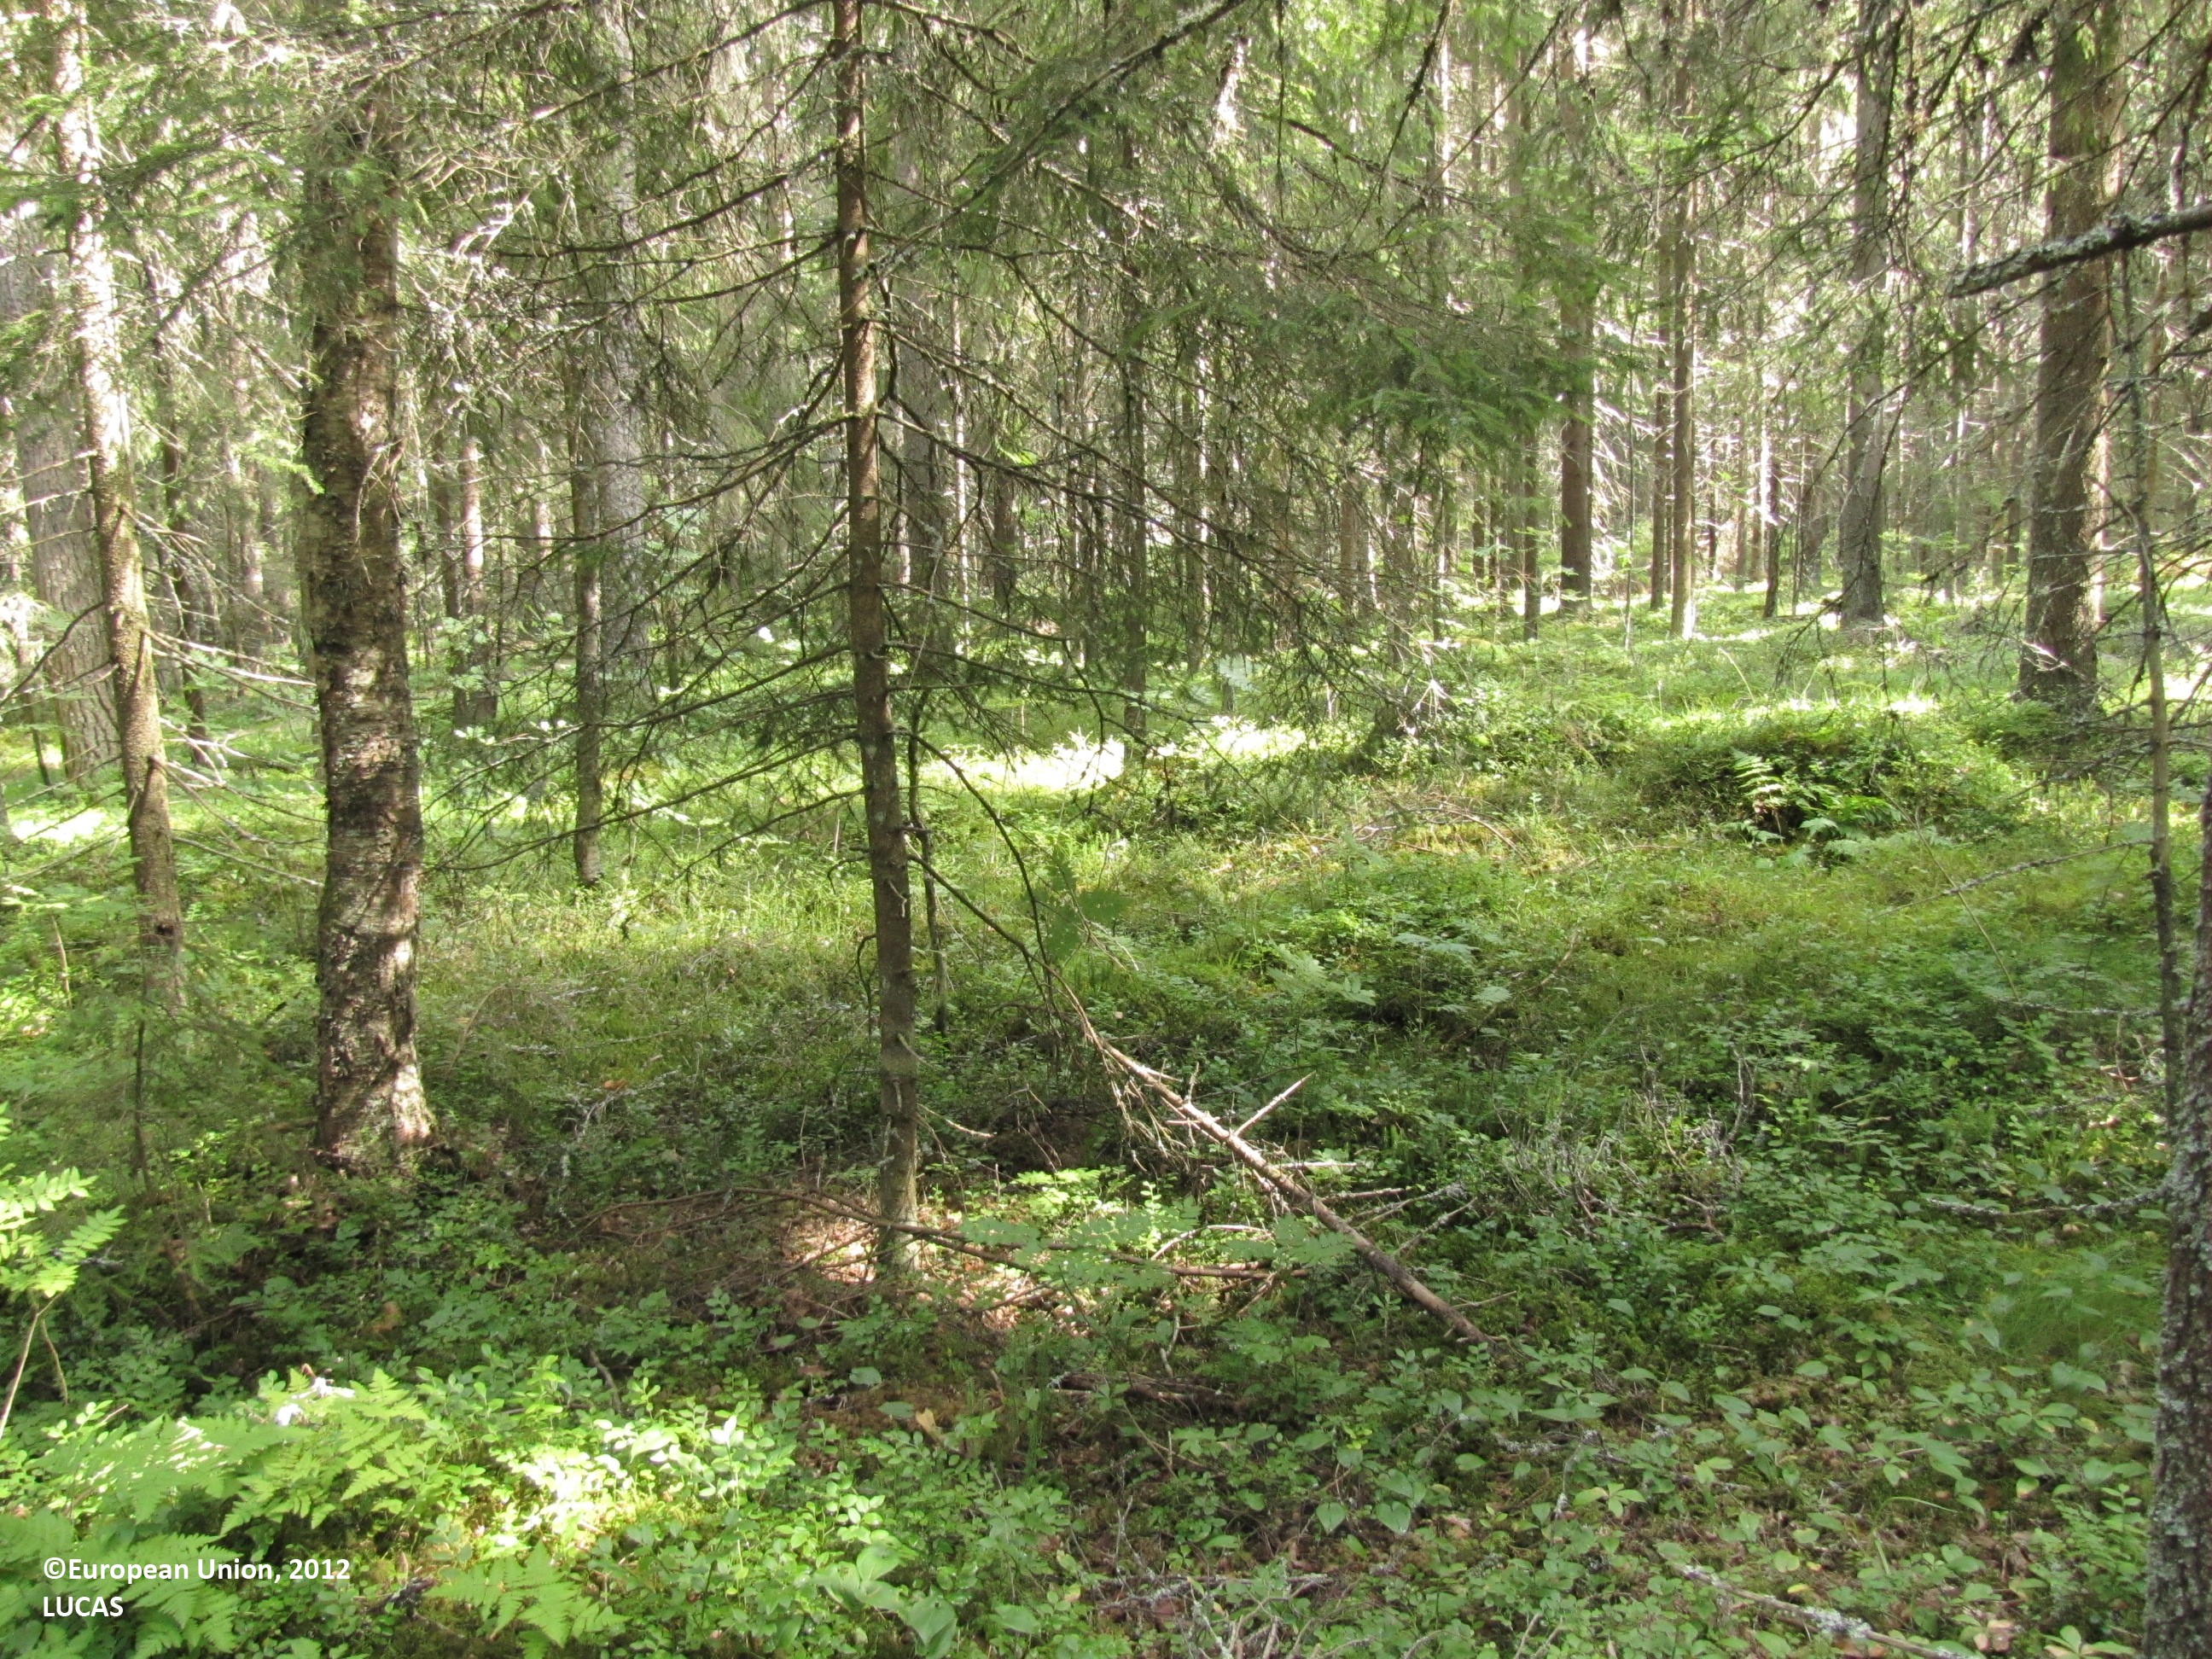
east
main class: Woodland
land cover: Spruce dominated coniferous woodland
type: boreal forest
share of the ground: > 75 %
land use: Forestry
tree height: > 5 m
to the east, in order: Spruce dominated coniferous woodland; Tracks; Spruce dominated coniferous woodland; Grassland with sparse tree/shrub cover; Other mixed woodland; Ditches and canals; Grassland without tree/shrub cover; Ditches and canals; Grassland without tree/shrub cover; Ditches and canals; Grassland without tree/shrub cover; Ditches and canals
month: July
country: FI
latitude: 62.4717
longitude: 23.1568
